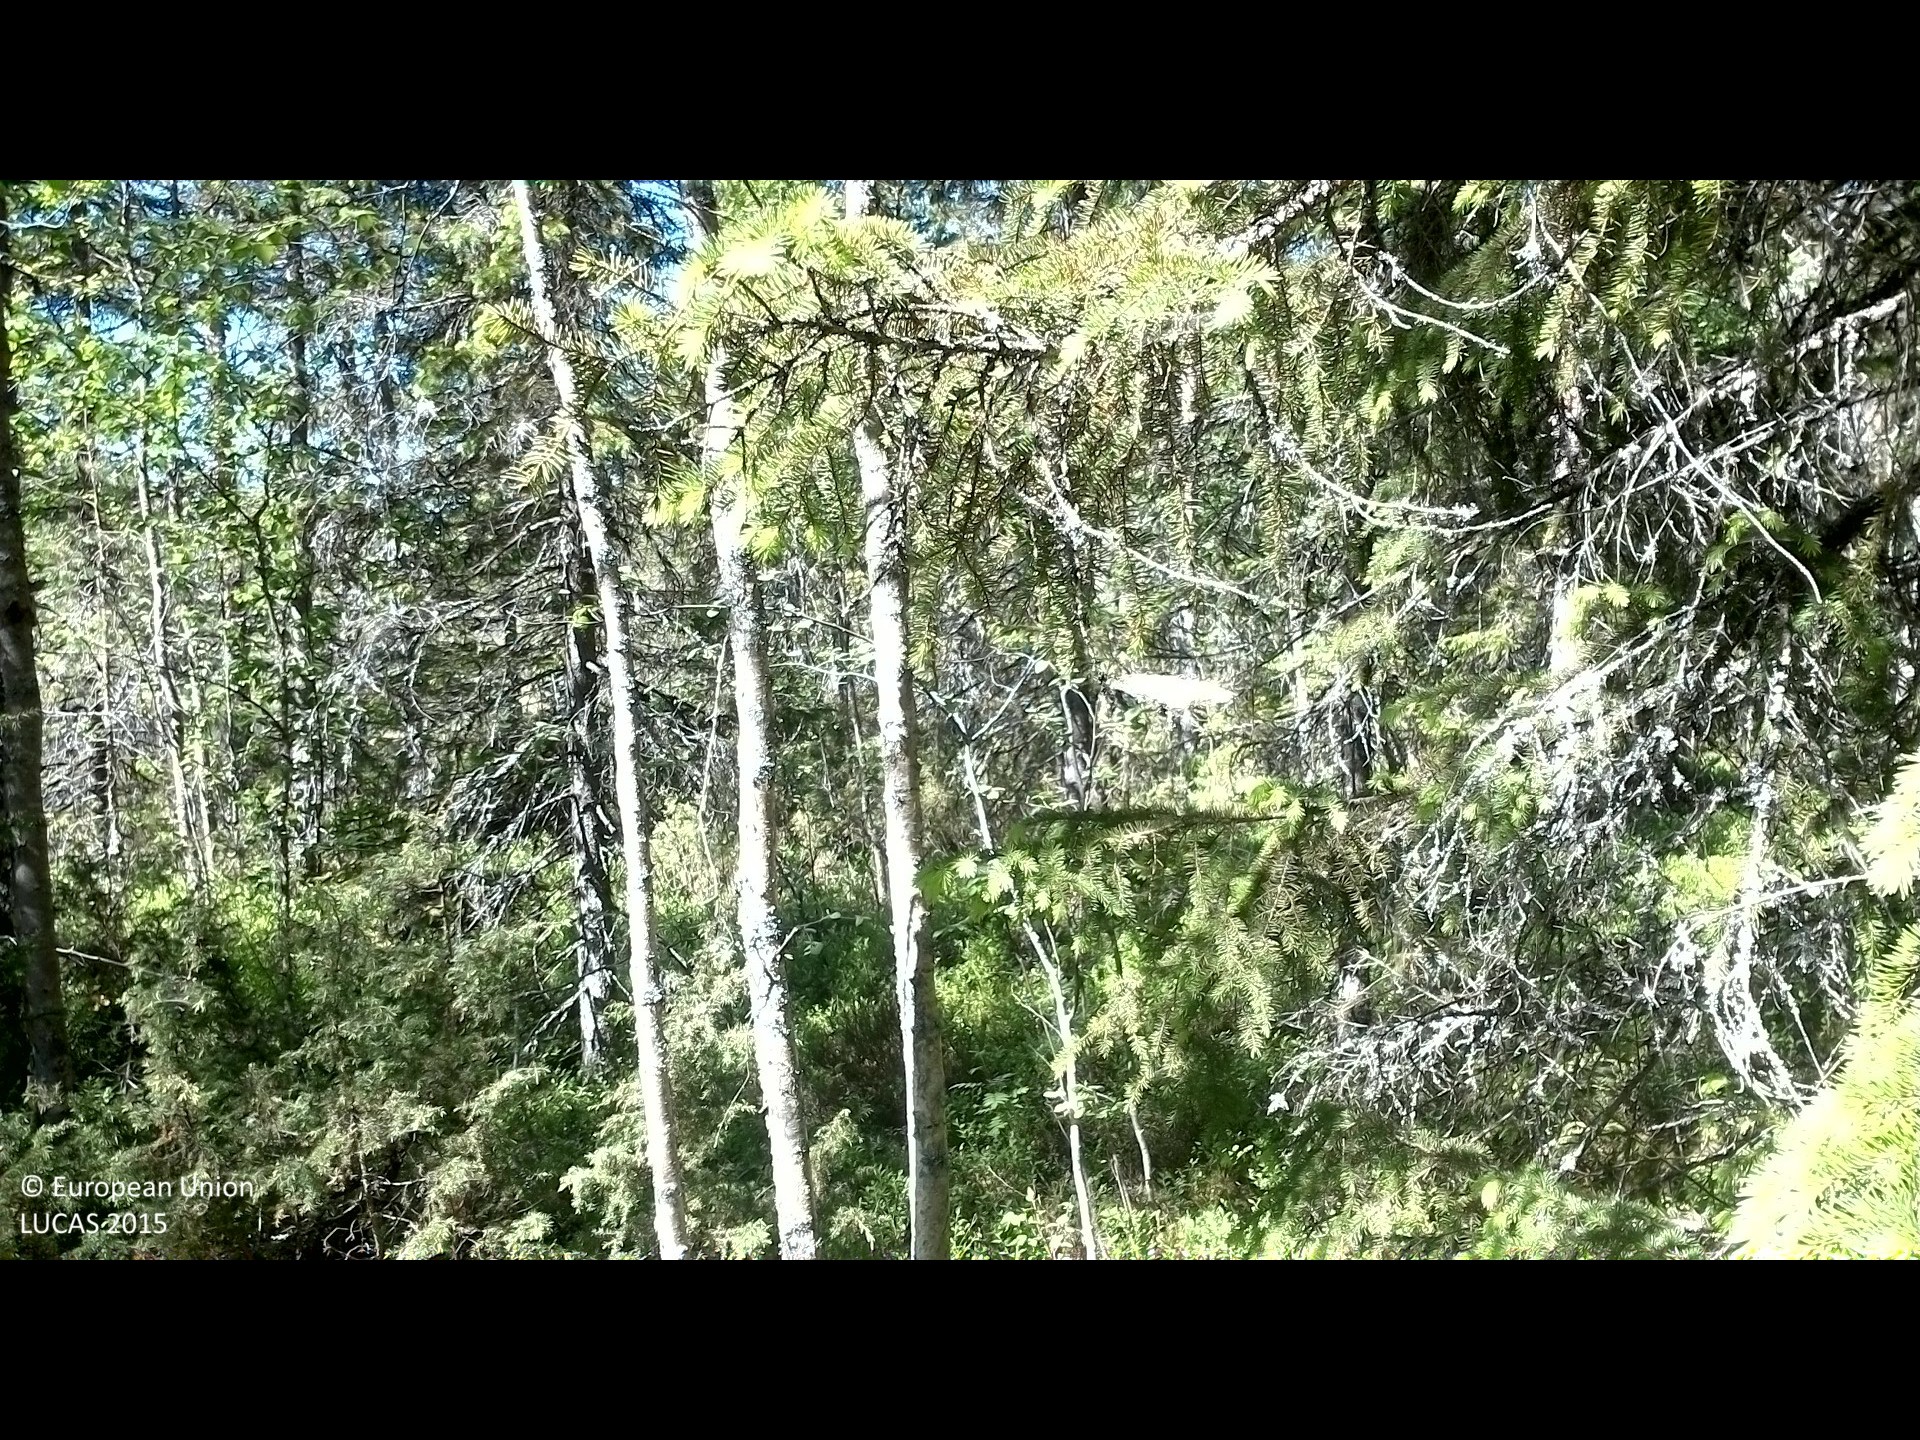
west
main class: Woodland
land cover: Pine dominated mixed woodland
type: boreal forest
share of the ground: 50 - 75 %
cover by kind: coniferous forest trees 40 %, shrubs 25 %, broadleaved forest trees 20 %, lichens and mosses 15 %
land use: Forestry
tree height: > 5 m
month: June
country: SE
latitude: 62.0179
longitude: 16.1142
